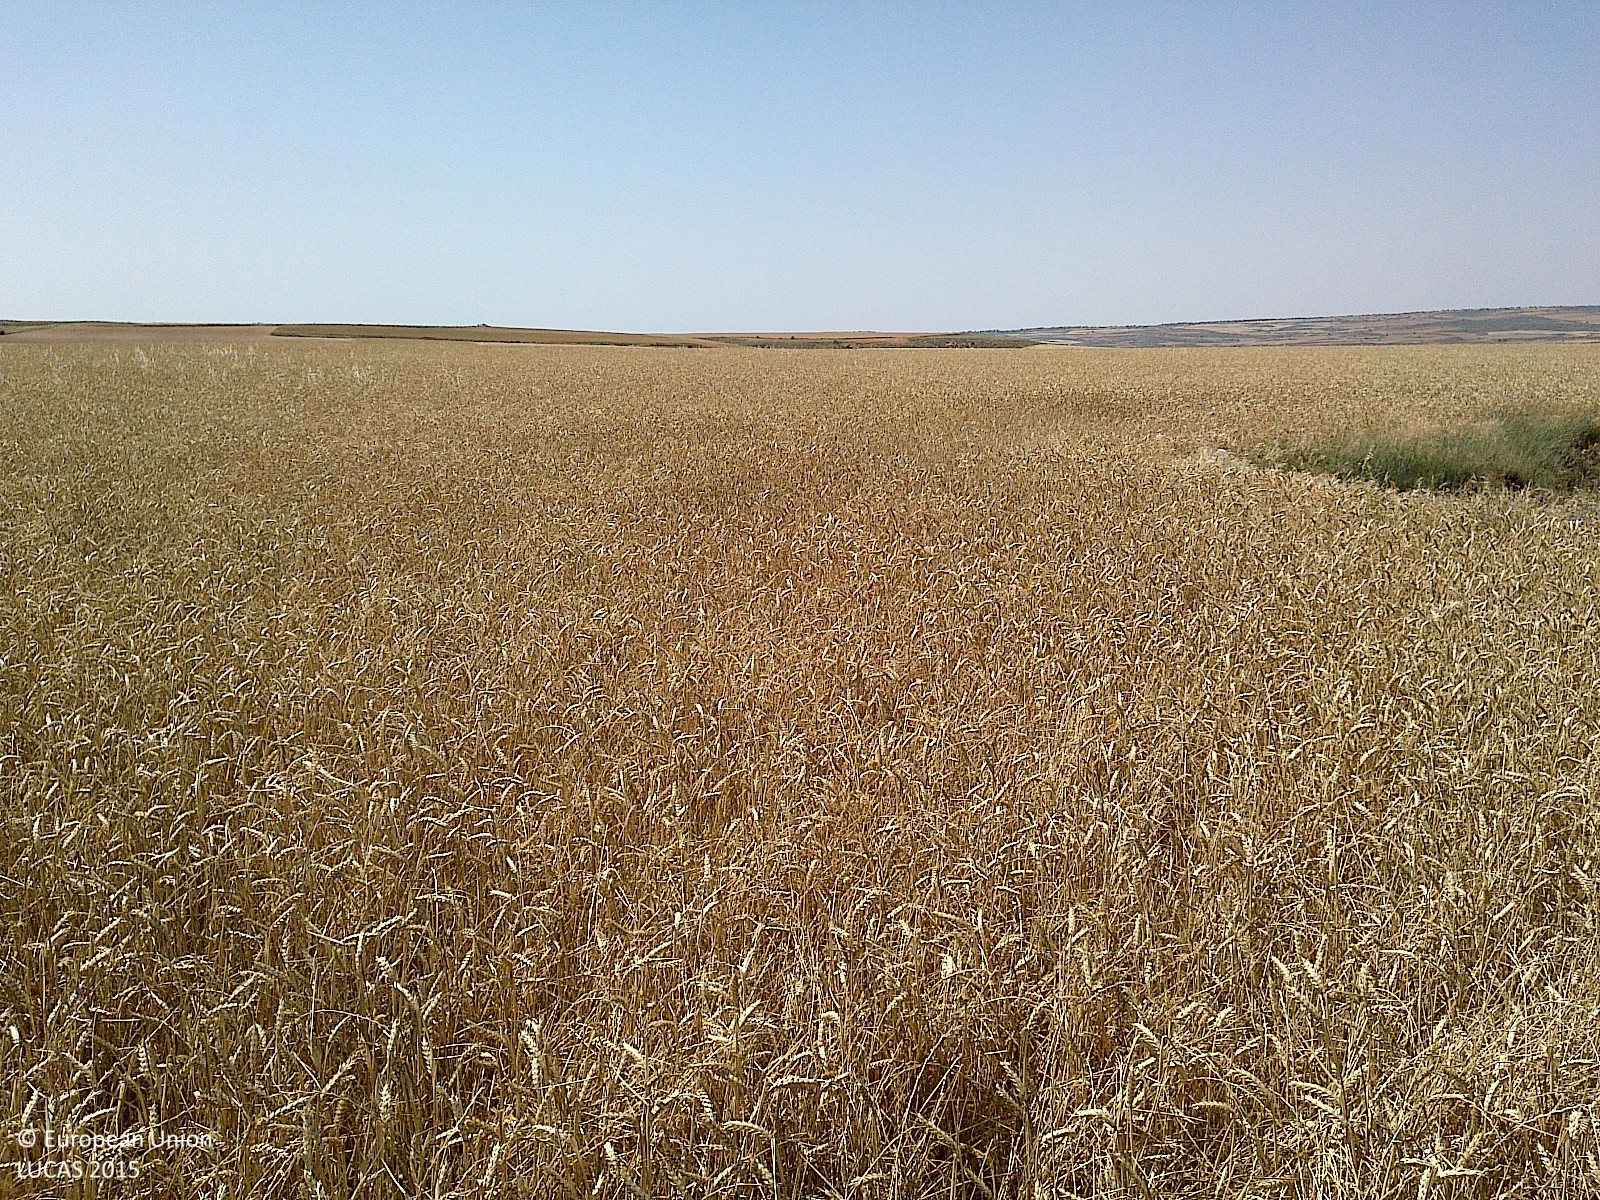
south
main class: Cropland
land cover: Common wheat
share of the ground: > 75 %
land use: Agriculture (excluding fallow land and kitchen gardens)
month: July
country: ES
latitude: 41.5928
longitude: -2.1371
